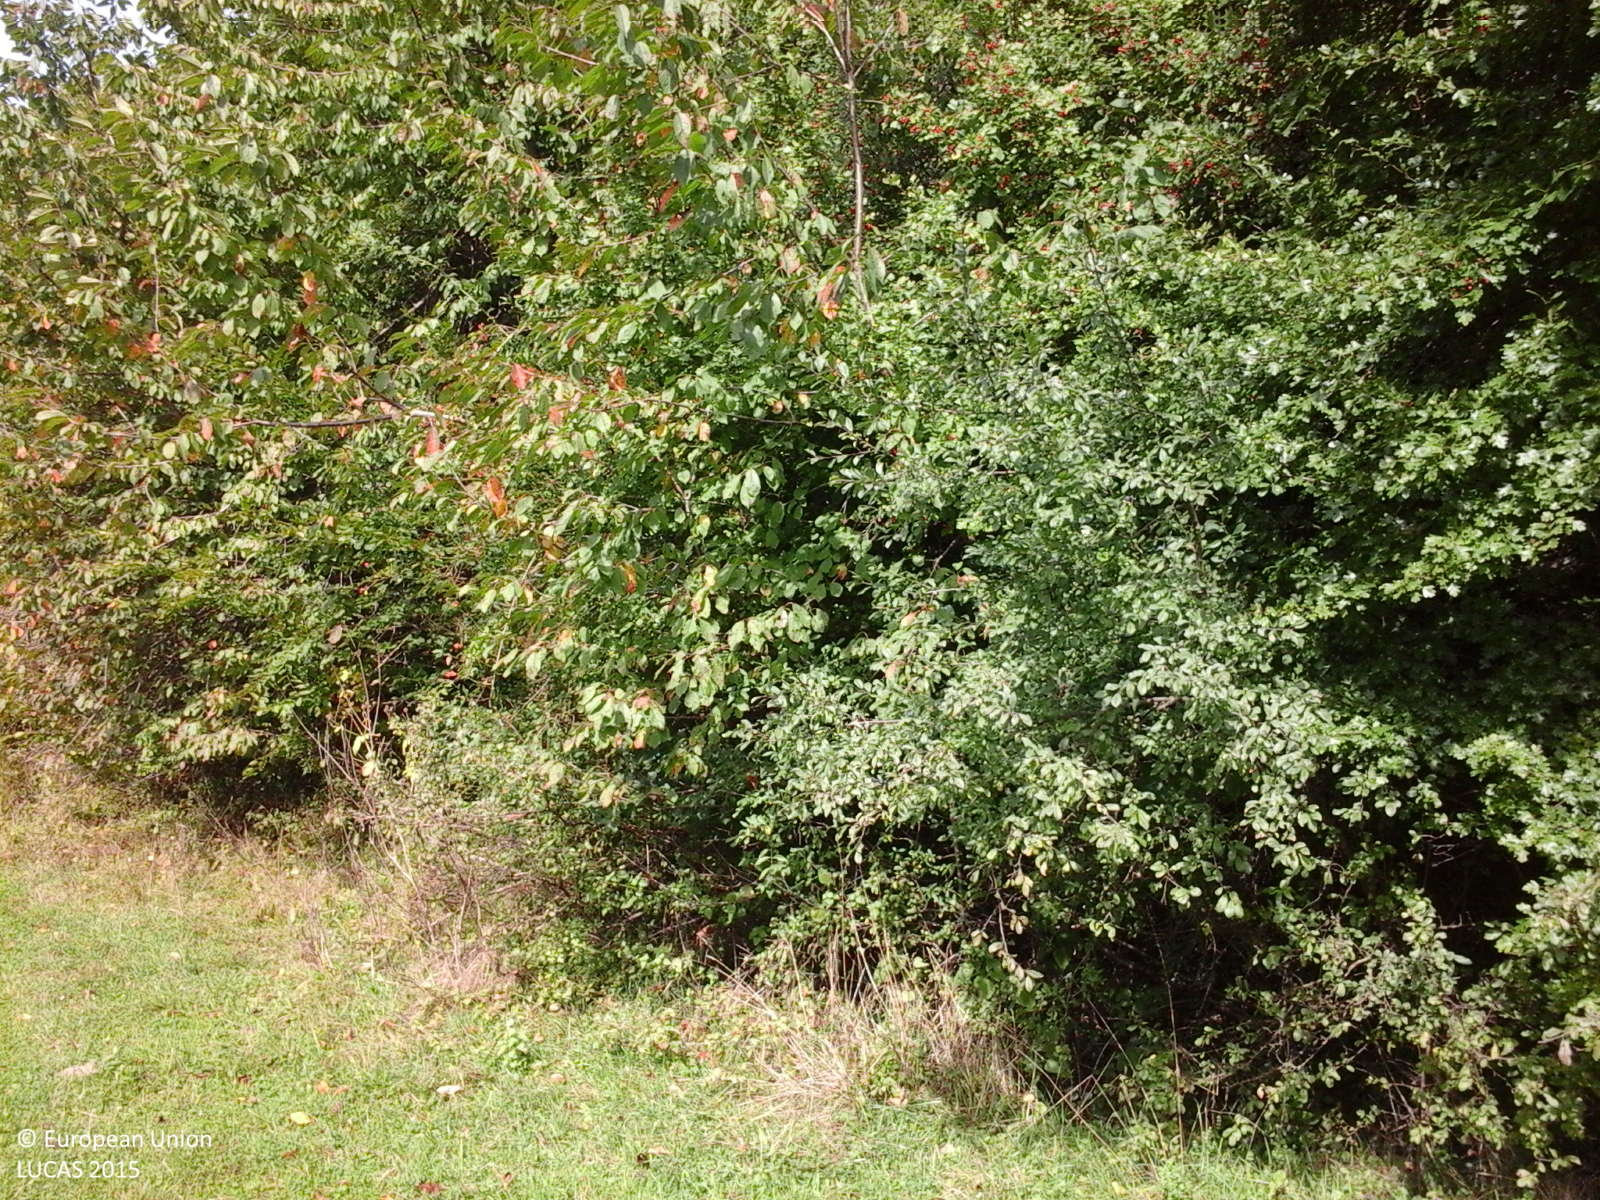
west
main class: Woodland
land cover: Broadleaved woodland
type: mesophytic deciduous forest
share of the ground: > 75 %
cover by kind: broadleaved forest trees 100 %
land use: Forestry
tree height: > 5 m
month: September
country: RO
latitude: 46.8009
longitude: 22.9400
